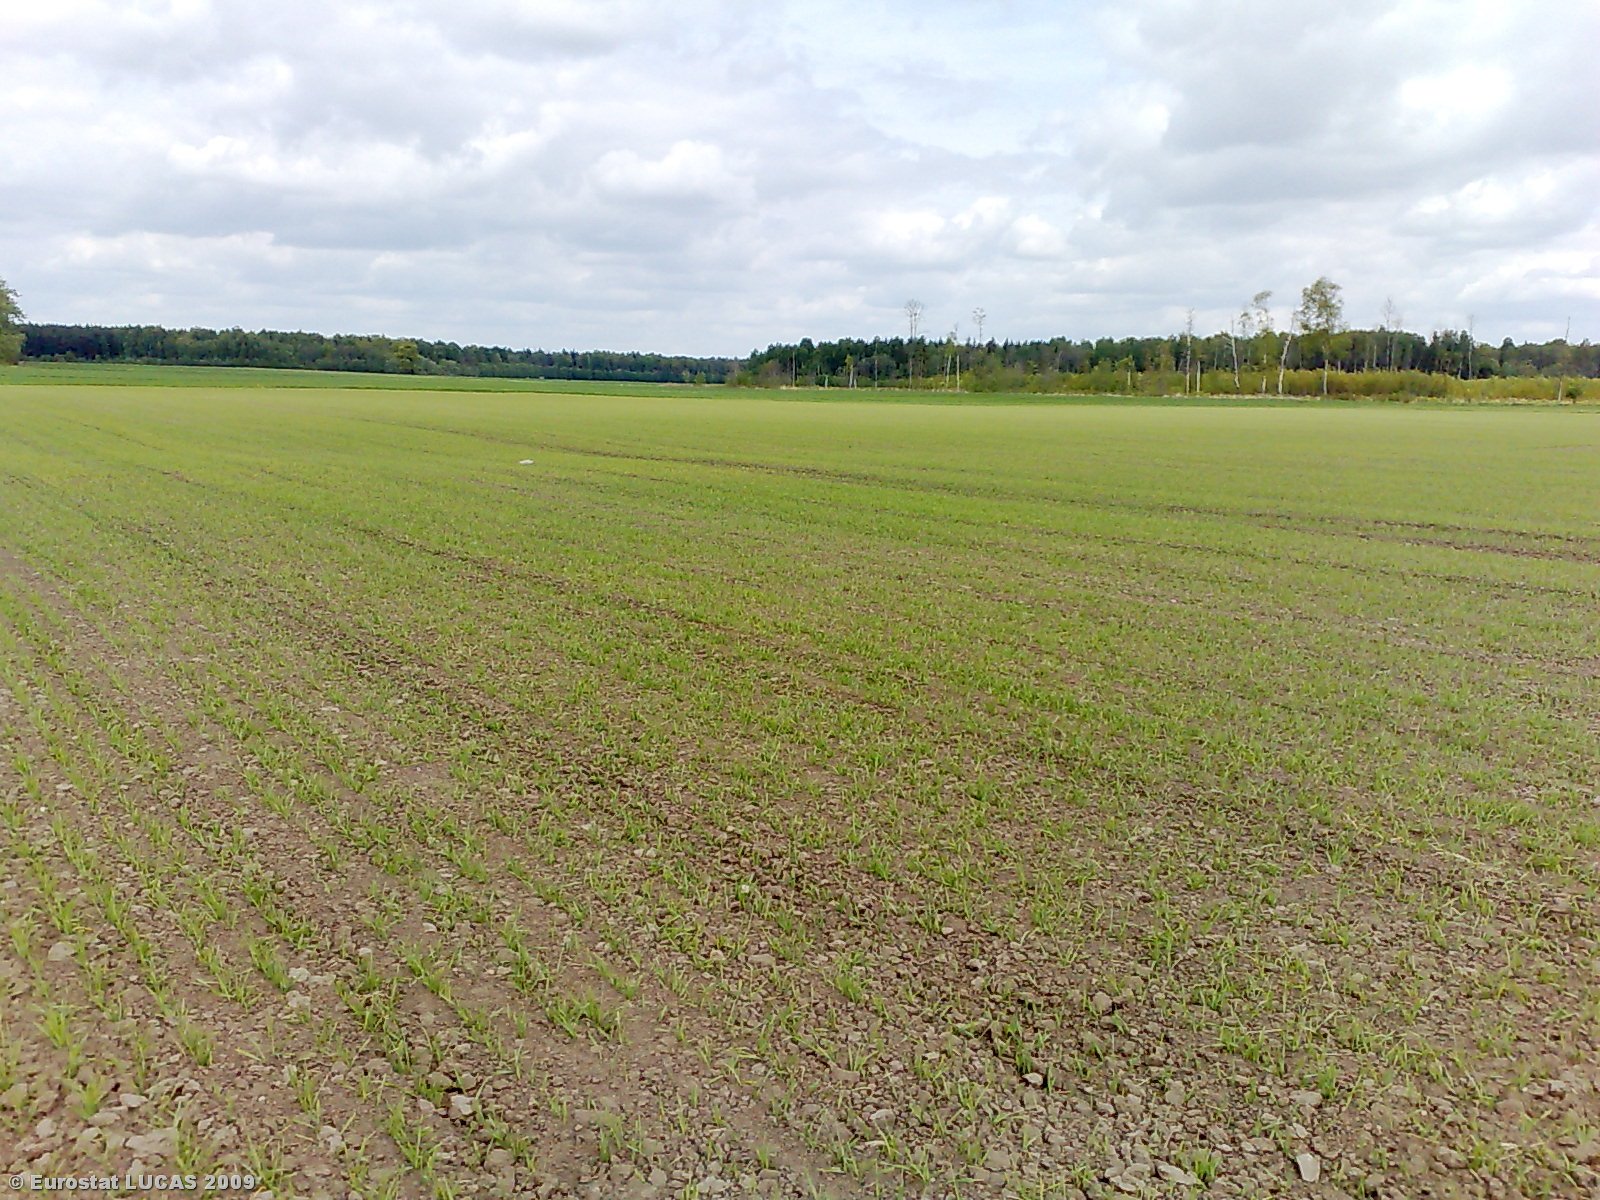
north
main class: Cropland
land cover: Barley
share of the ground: 25 - 50 %
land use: Agriculture (excluding fallow land and kitchen gardens)
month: May
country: LT
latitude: 55.6529
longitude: 23.8321
